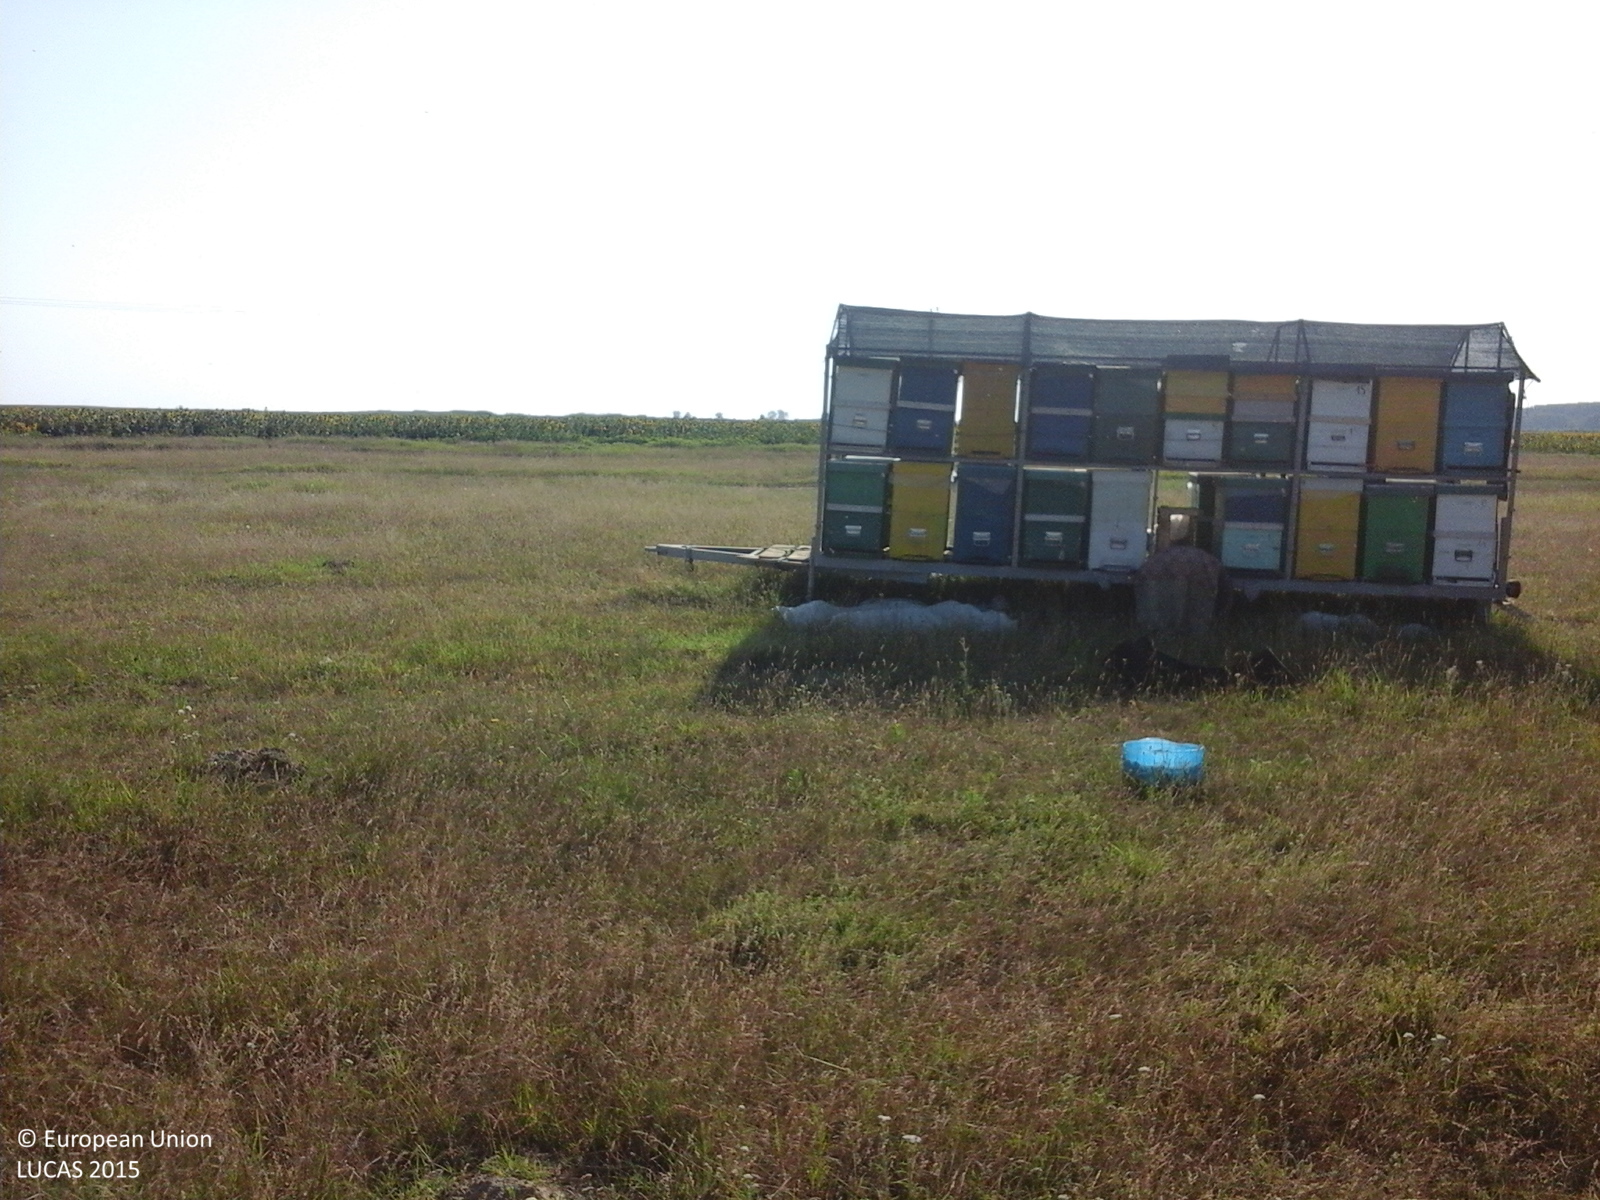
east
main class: Grassland
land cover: Grassland without tree/shrub cover
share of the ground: > 75 %
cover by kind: herbaceous plants 100 %
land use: Agriculture (excluding fallow land and kitchen gardens)
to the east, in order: Grassland without tree/shrub cover; Tracks; Grassland without tree/shrub cover; Tracks; Grassland without tree/shrub cover; Tracks; Grass margins; Electric lines; Sunflower; Grass margins; Tracks; Grass margins; Sunflower
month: July
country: RO
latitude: 44.1499
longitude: 26.8877
